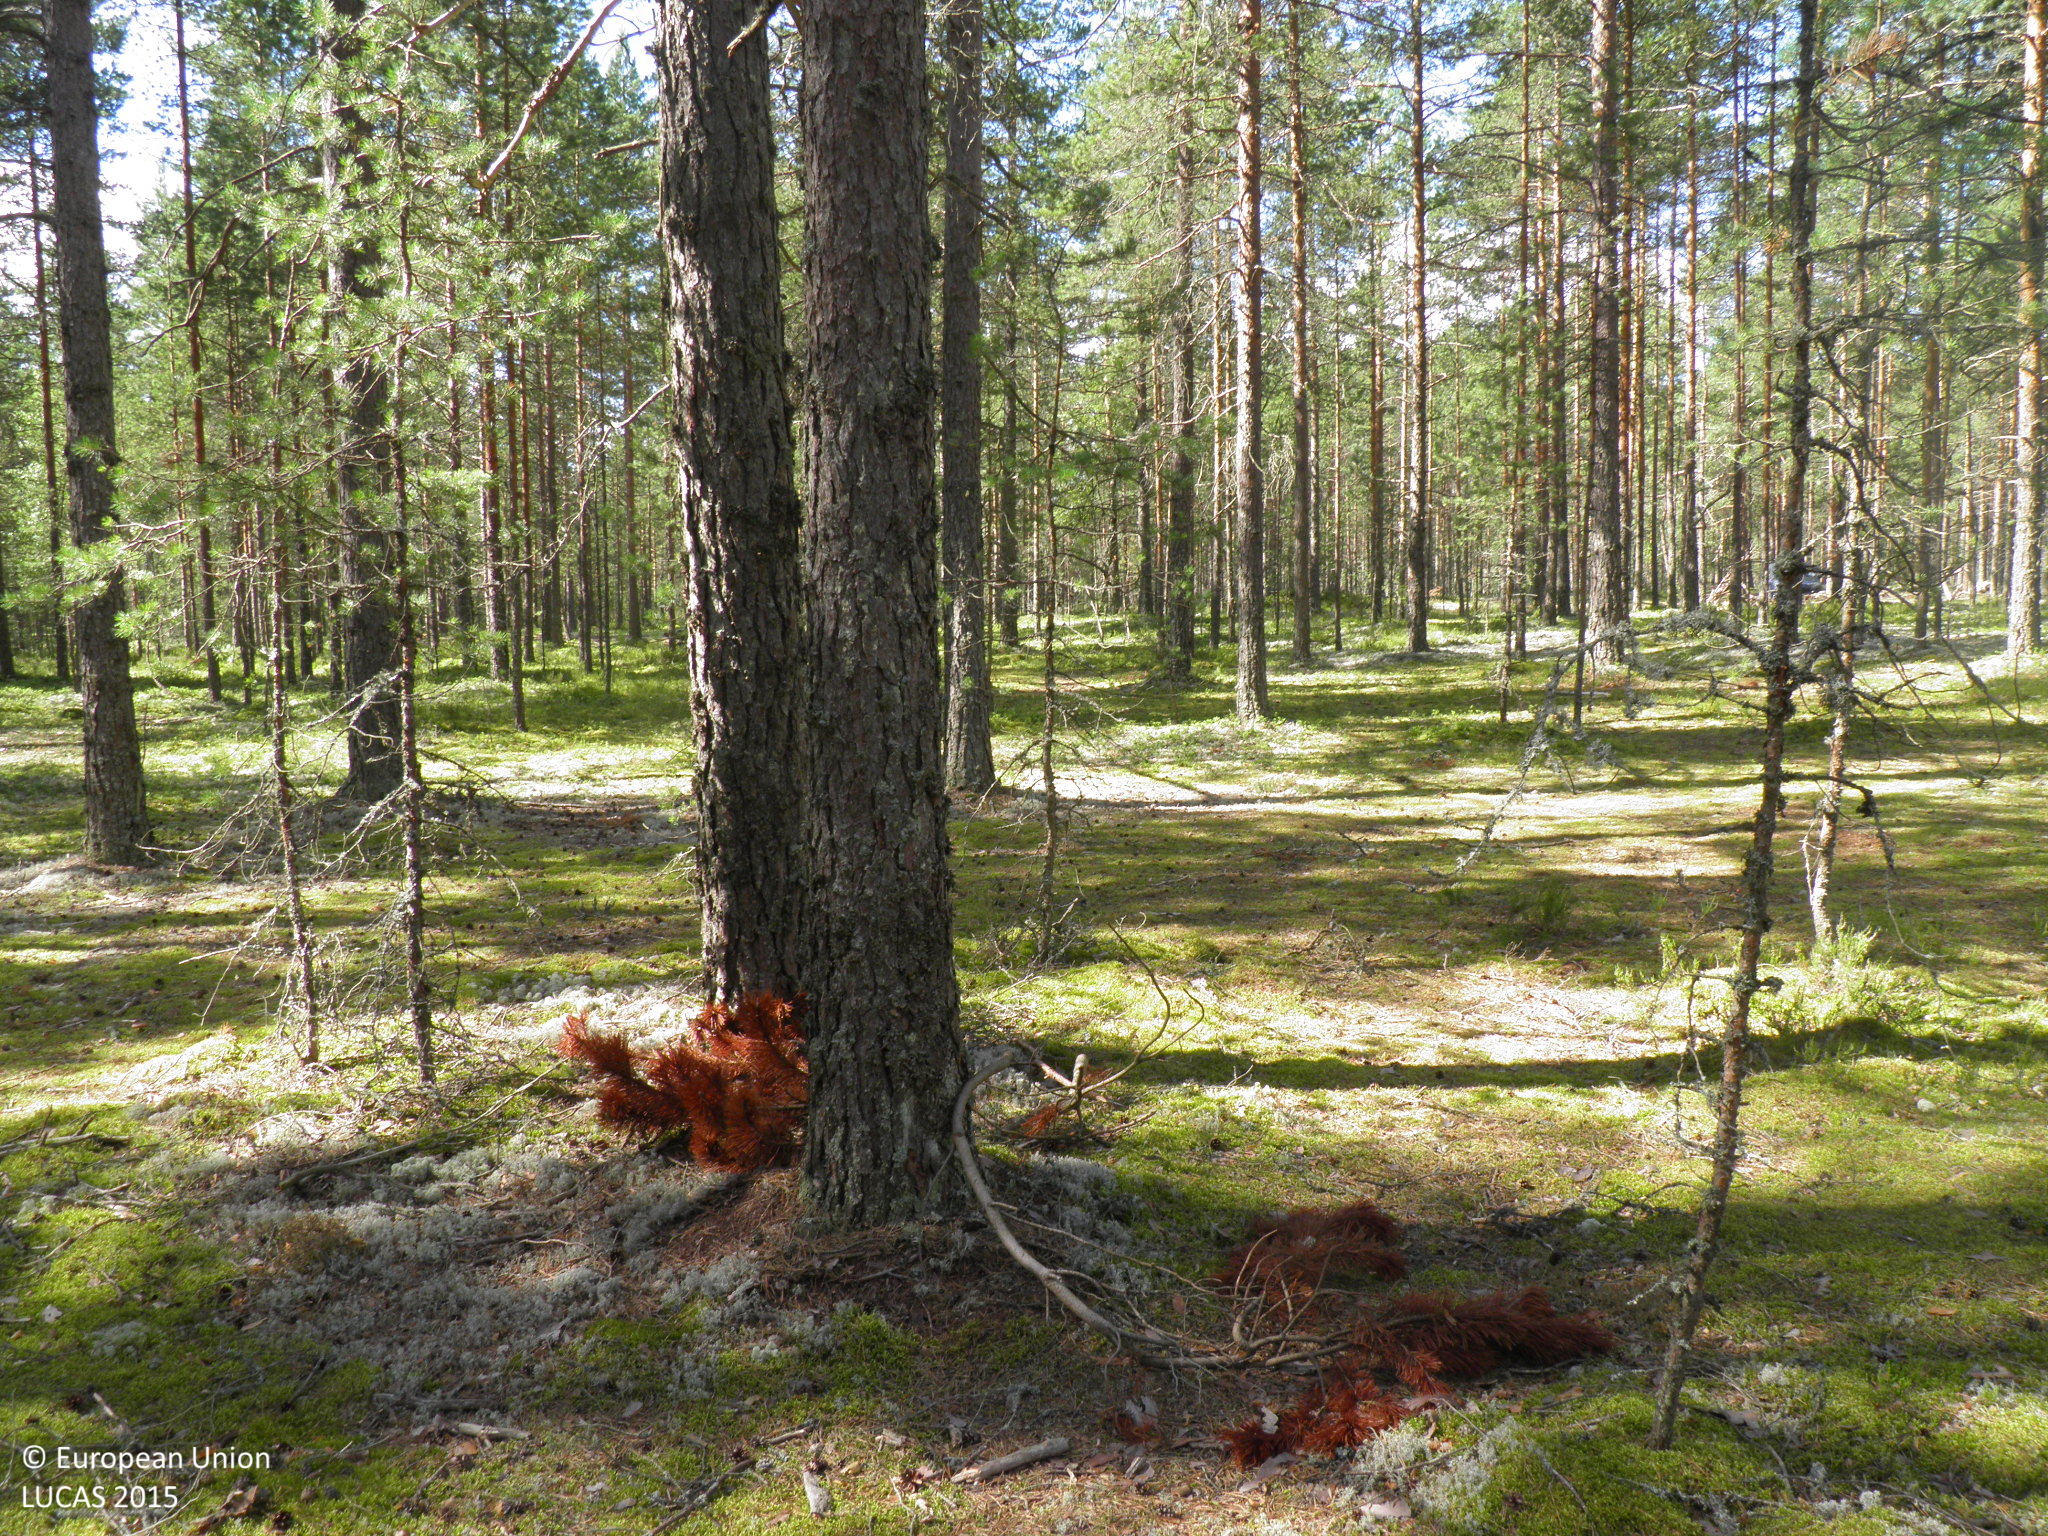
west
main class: Woodland
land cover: Pine dominated coniferous woodland
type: hemiboreal forest and nemoral coniferous forest and mixed broadleaved-coniferous forest
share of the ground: 50 - 75 %
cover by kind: coniferous forest trees 50 %, lichens and mosses 25 %, unconsolidated bare surface 25 %
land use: Forestry
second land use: Amenities, museums, leisure
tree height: > 5 m
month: August
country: FI
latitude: 60.9881
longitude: 22.5443
